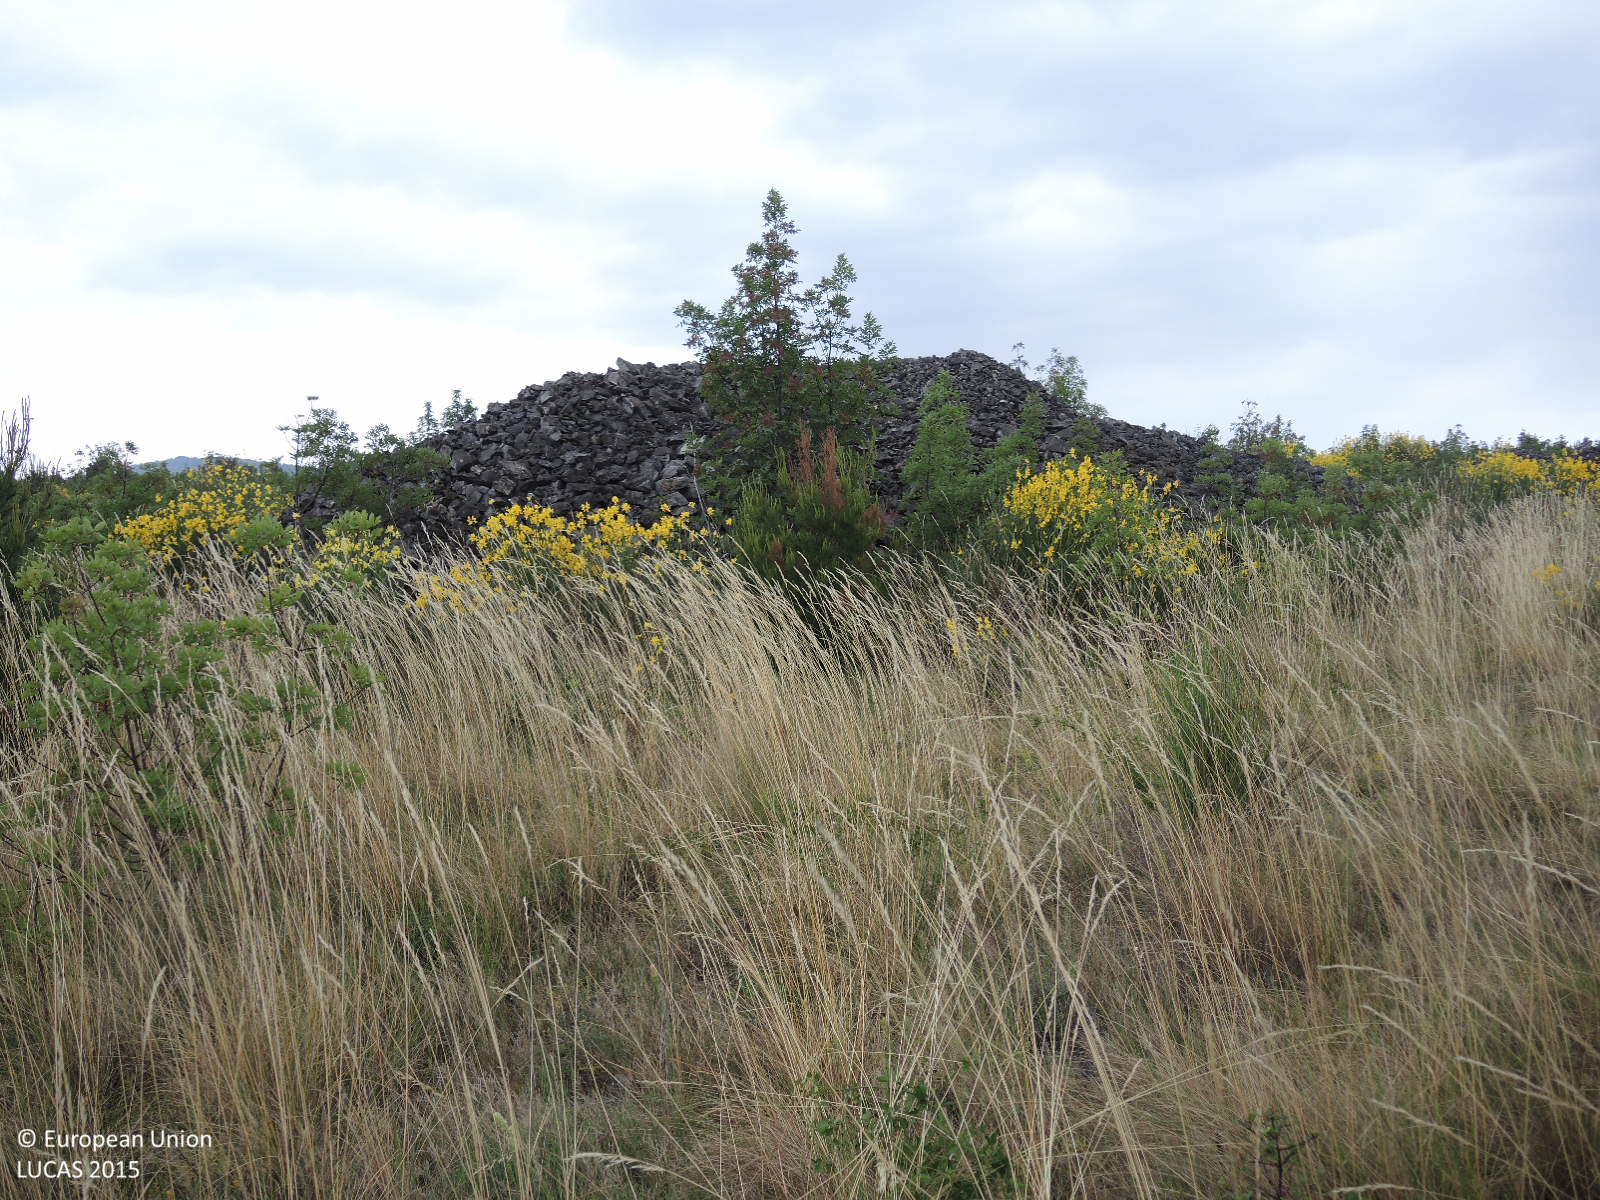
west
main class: Woodland
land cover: Pine dominated coniferous woodland
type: coniferous forest of the mediterranean region
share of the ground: 10 - 25 %
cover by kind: herbaceous plants 60 %, shrubs 20 %, coniferous forest trees 15 %, unconsolidated bare surface 5 %
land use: Semi-natural and natural areas not in use
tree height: < 5 m
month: May
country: HR
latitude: 43.7341
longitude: 15.8387
